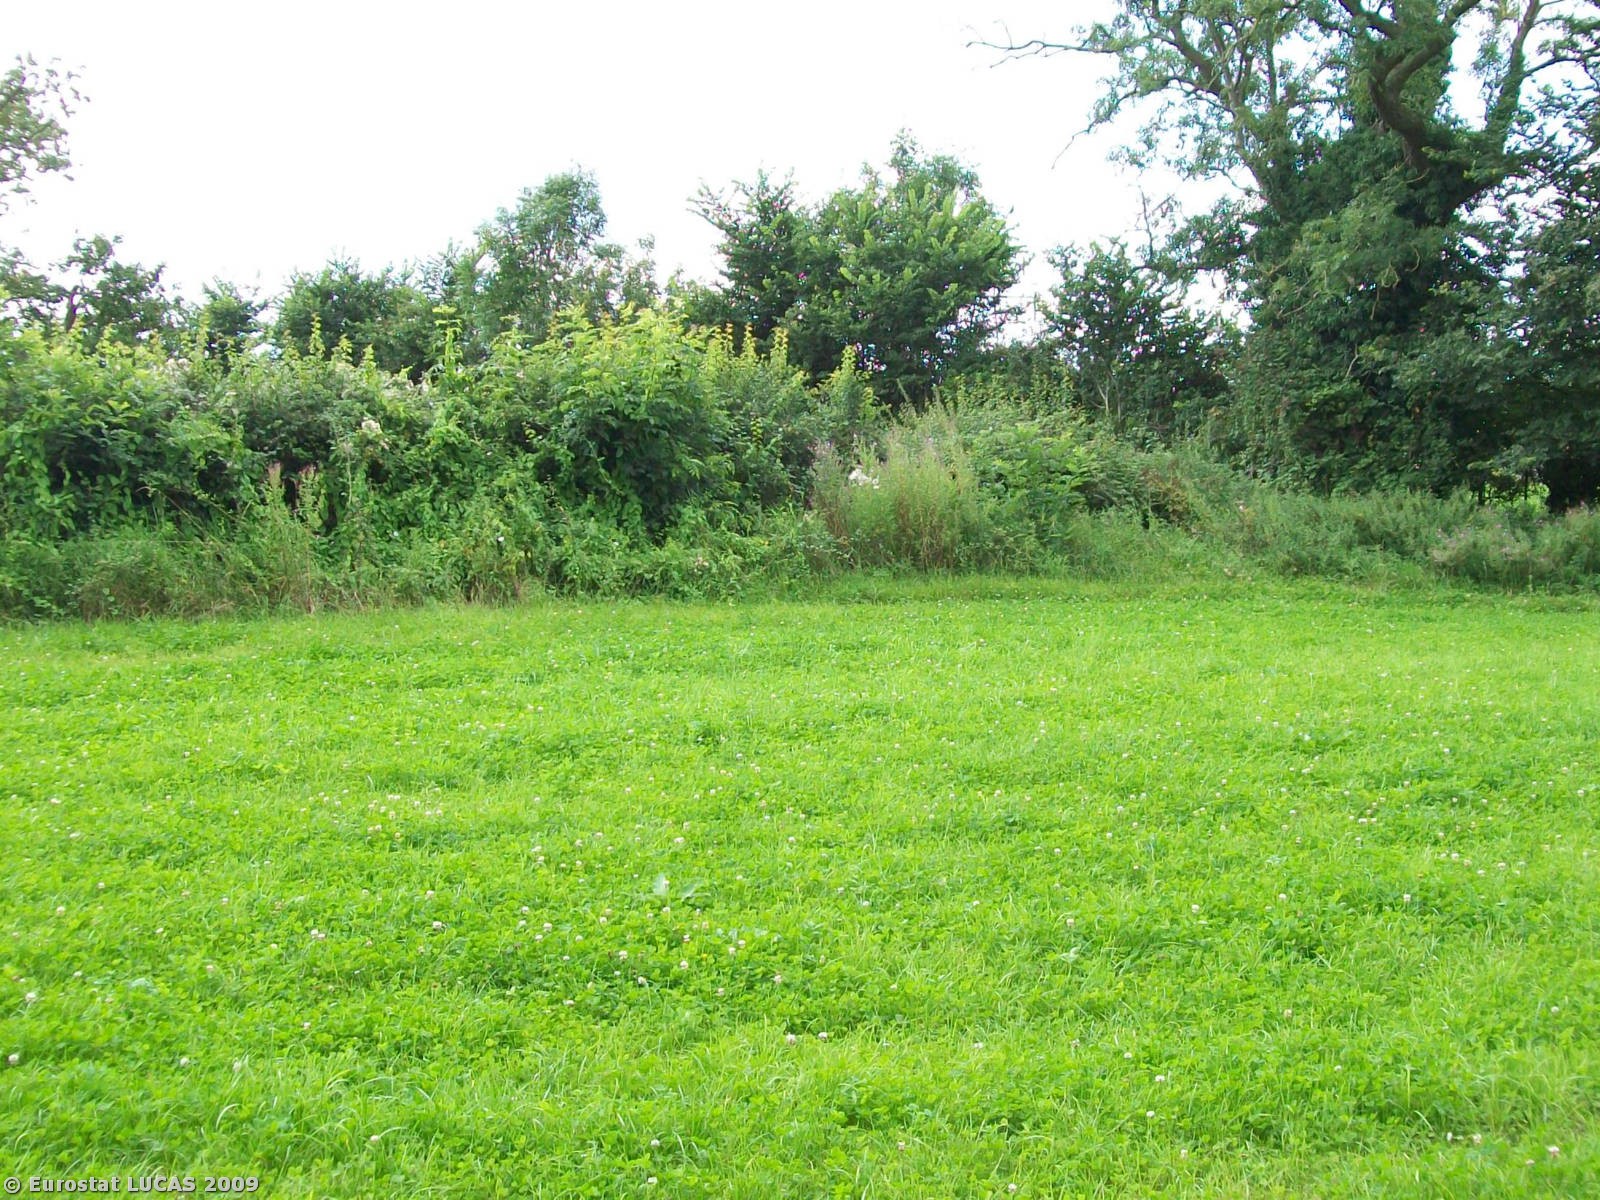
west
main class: Grassland
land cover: Grassland without tree/shrub cover
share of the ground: > 75 %
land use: Agriculture (excluding fallow land and kitchen gardens)
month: August
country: GB
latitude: 51.7965
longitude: -2.4044
